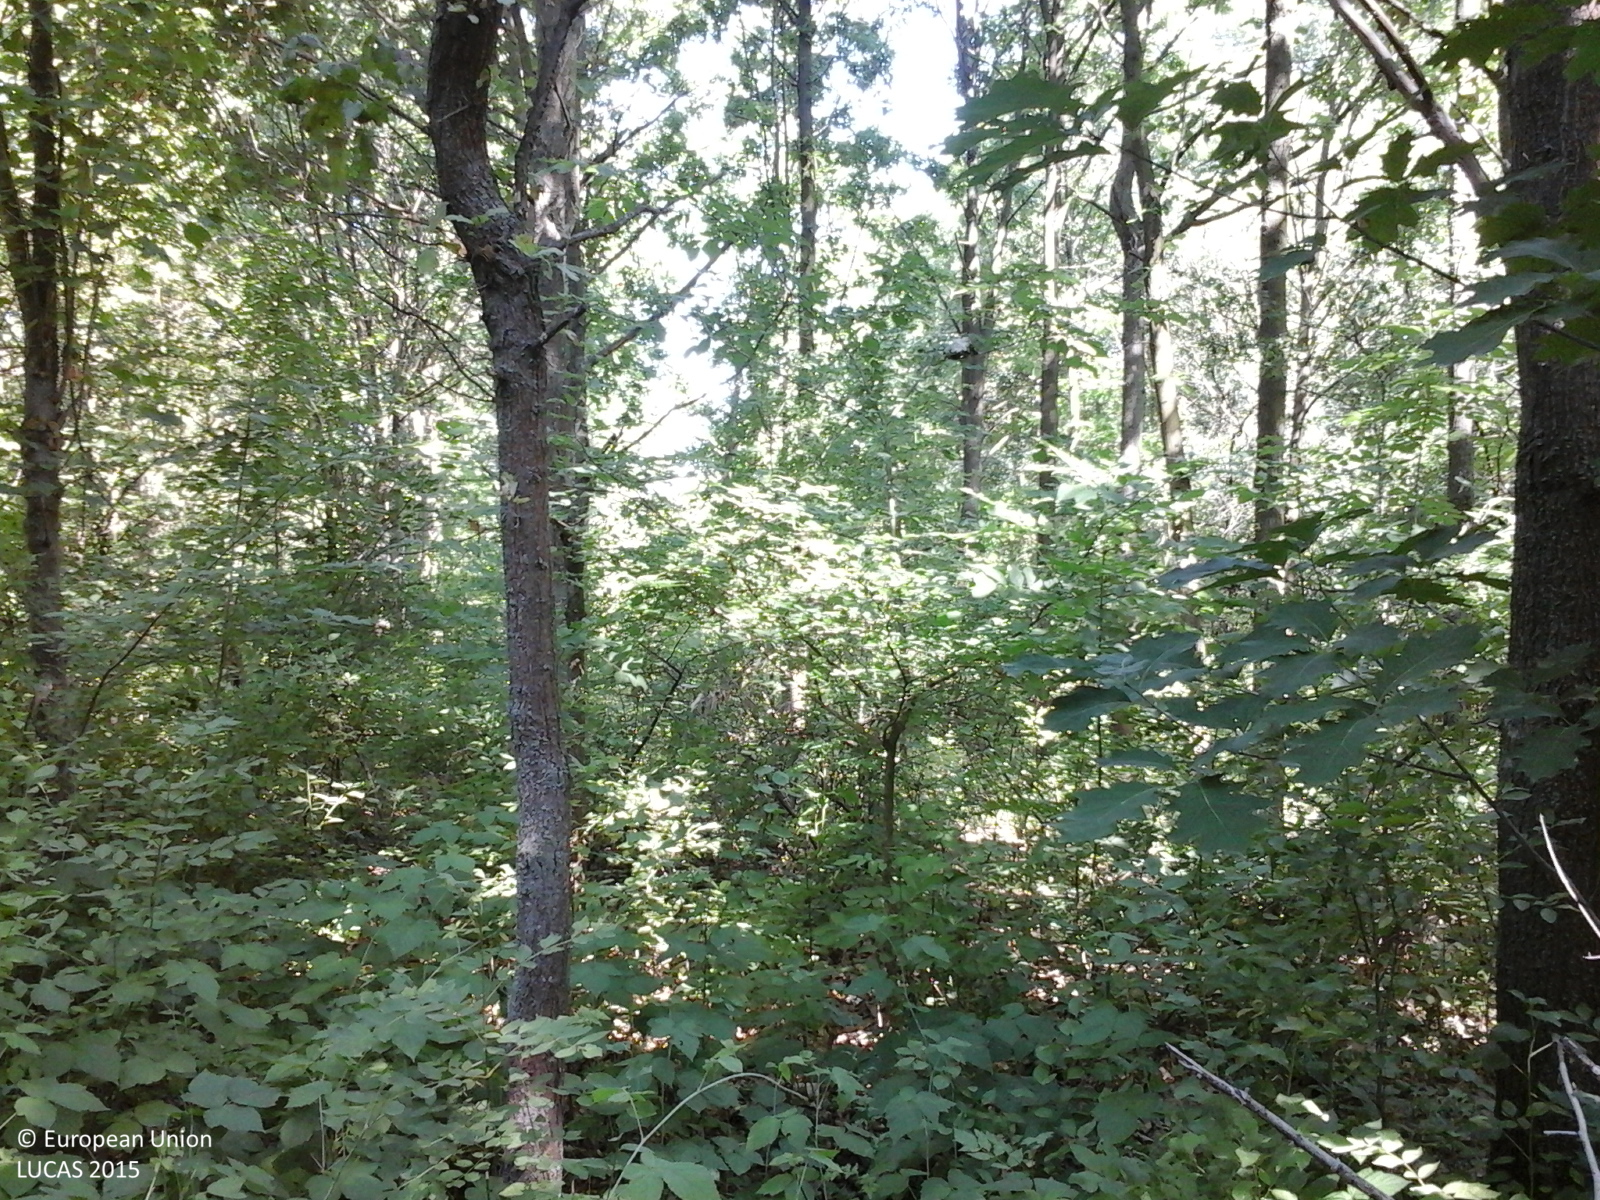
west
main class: Woodland
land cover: Broadleaved woodland
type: acidophilous oak and oak-birch forest
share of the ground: > 75 %
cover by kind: broadleaved forest trees 90 %, shrubs 5 %, herbaceous plants 5 %
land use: Forestry
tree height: > 5 m
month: June
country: RO
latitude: 47.0576
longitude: 27.8872
